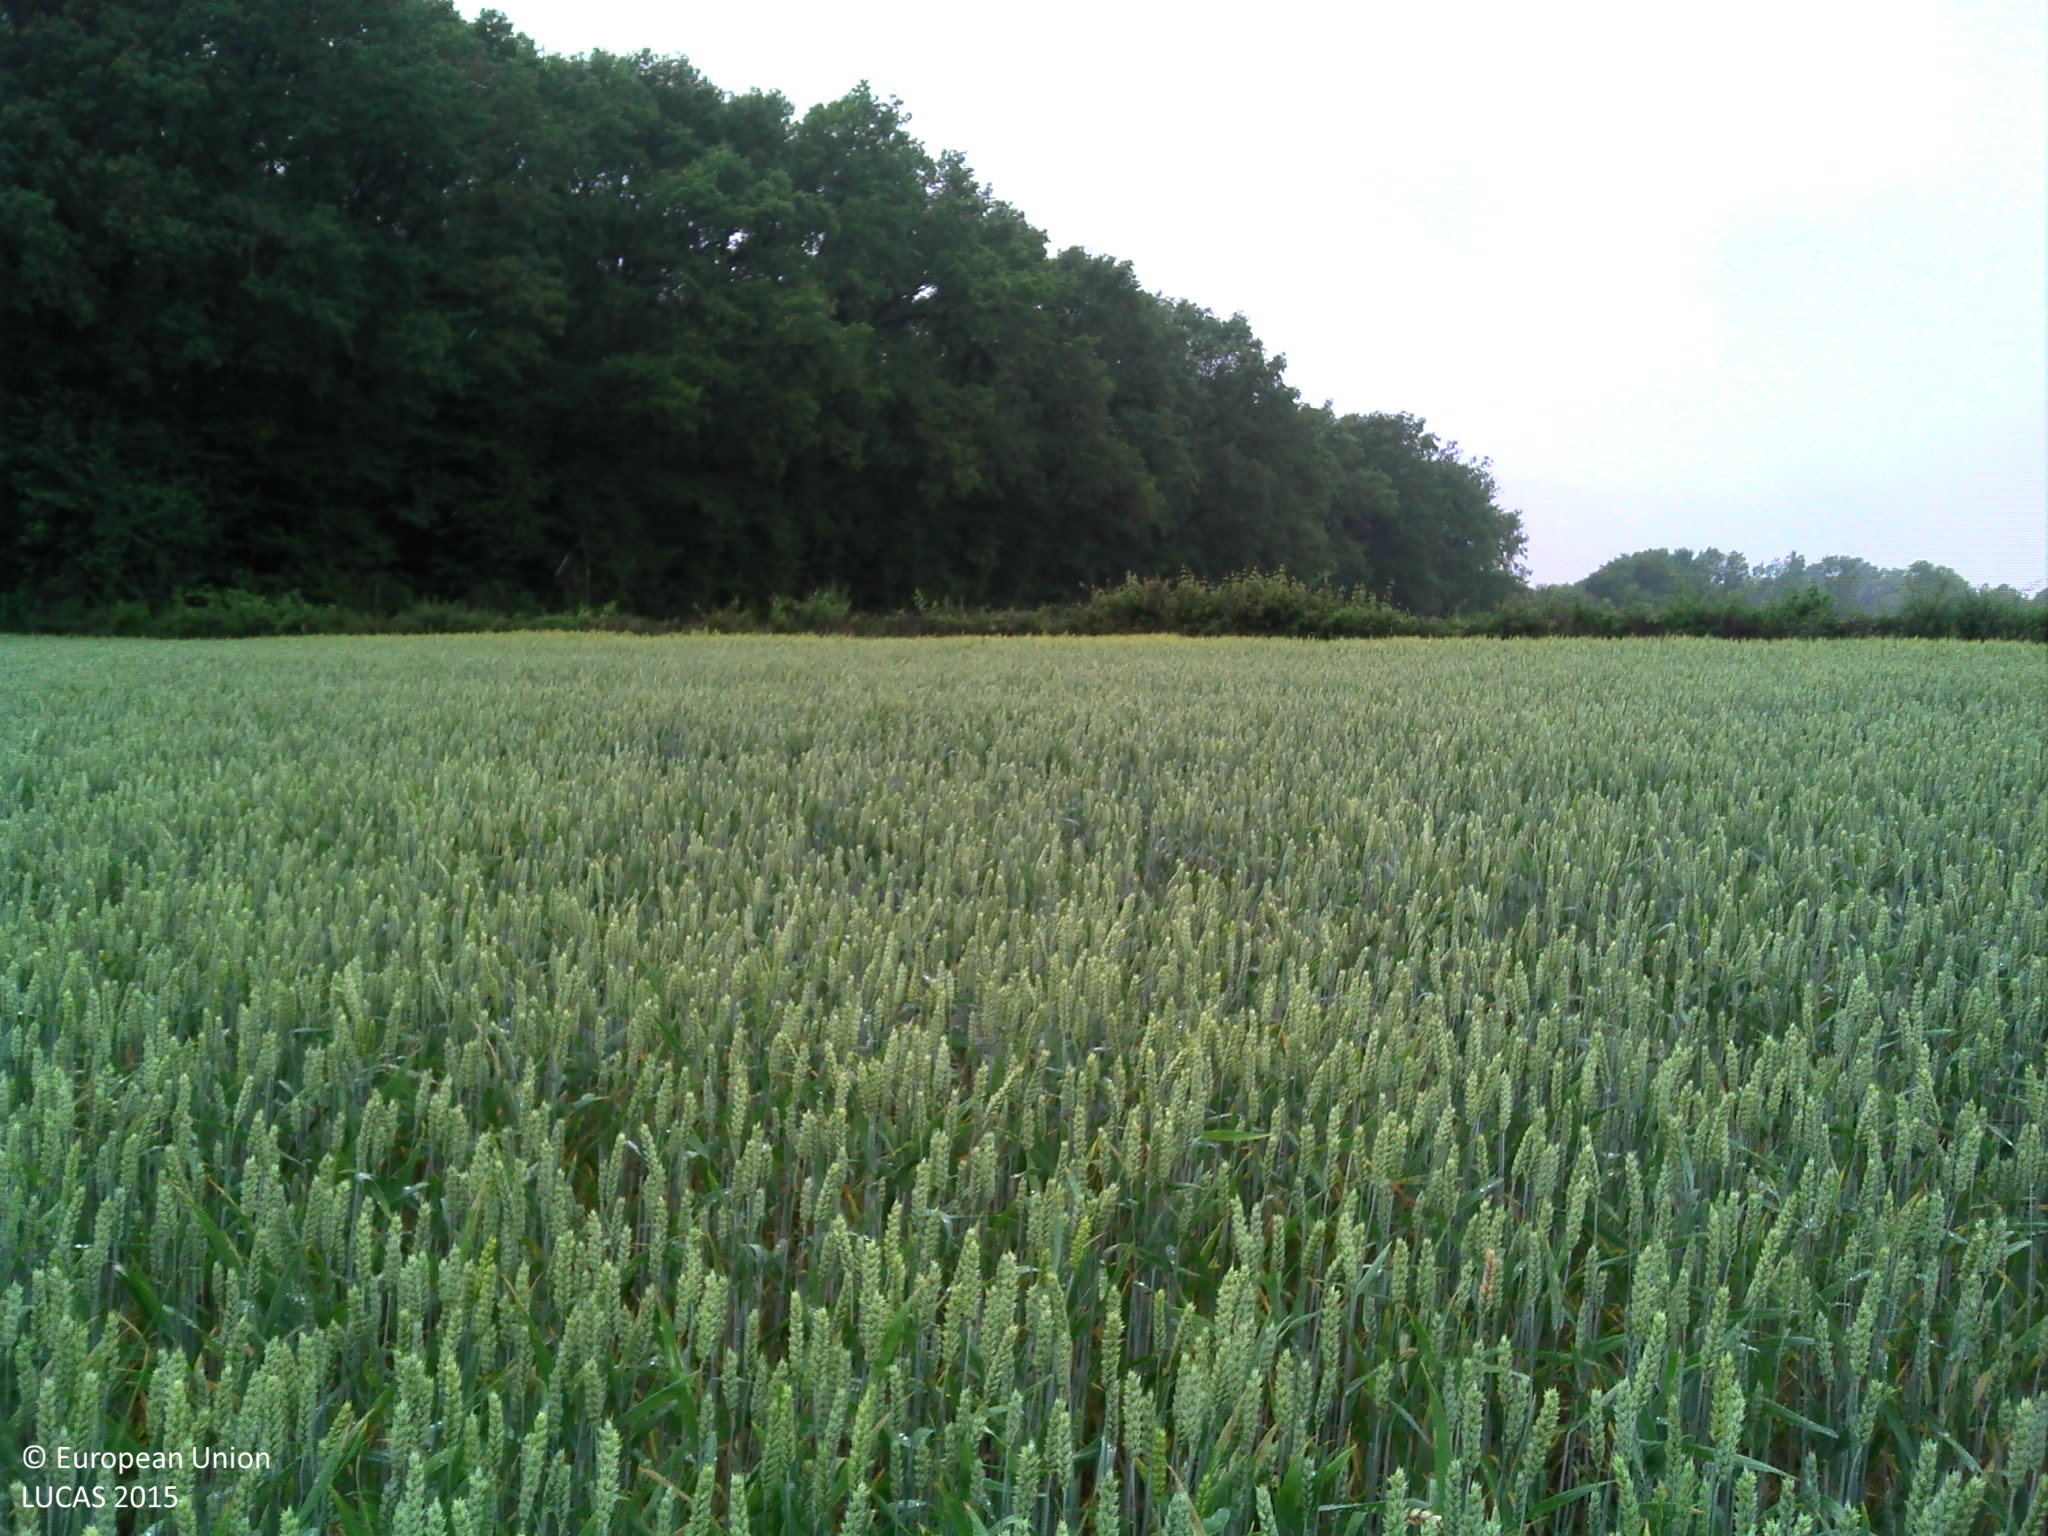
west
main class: Cropland
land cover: Common wheat
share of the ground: > 75 %
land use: Agriculture (excluding fallow land and kitchen gardens)
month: June
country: FR
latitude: 47.5207
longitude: 2.5685
